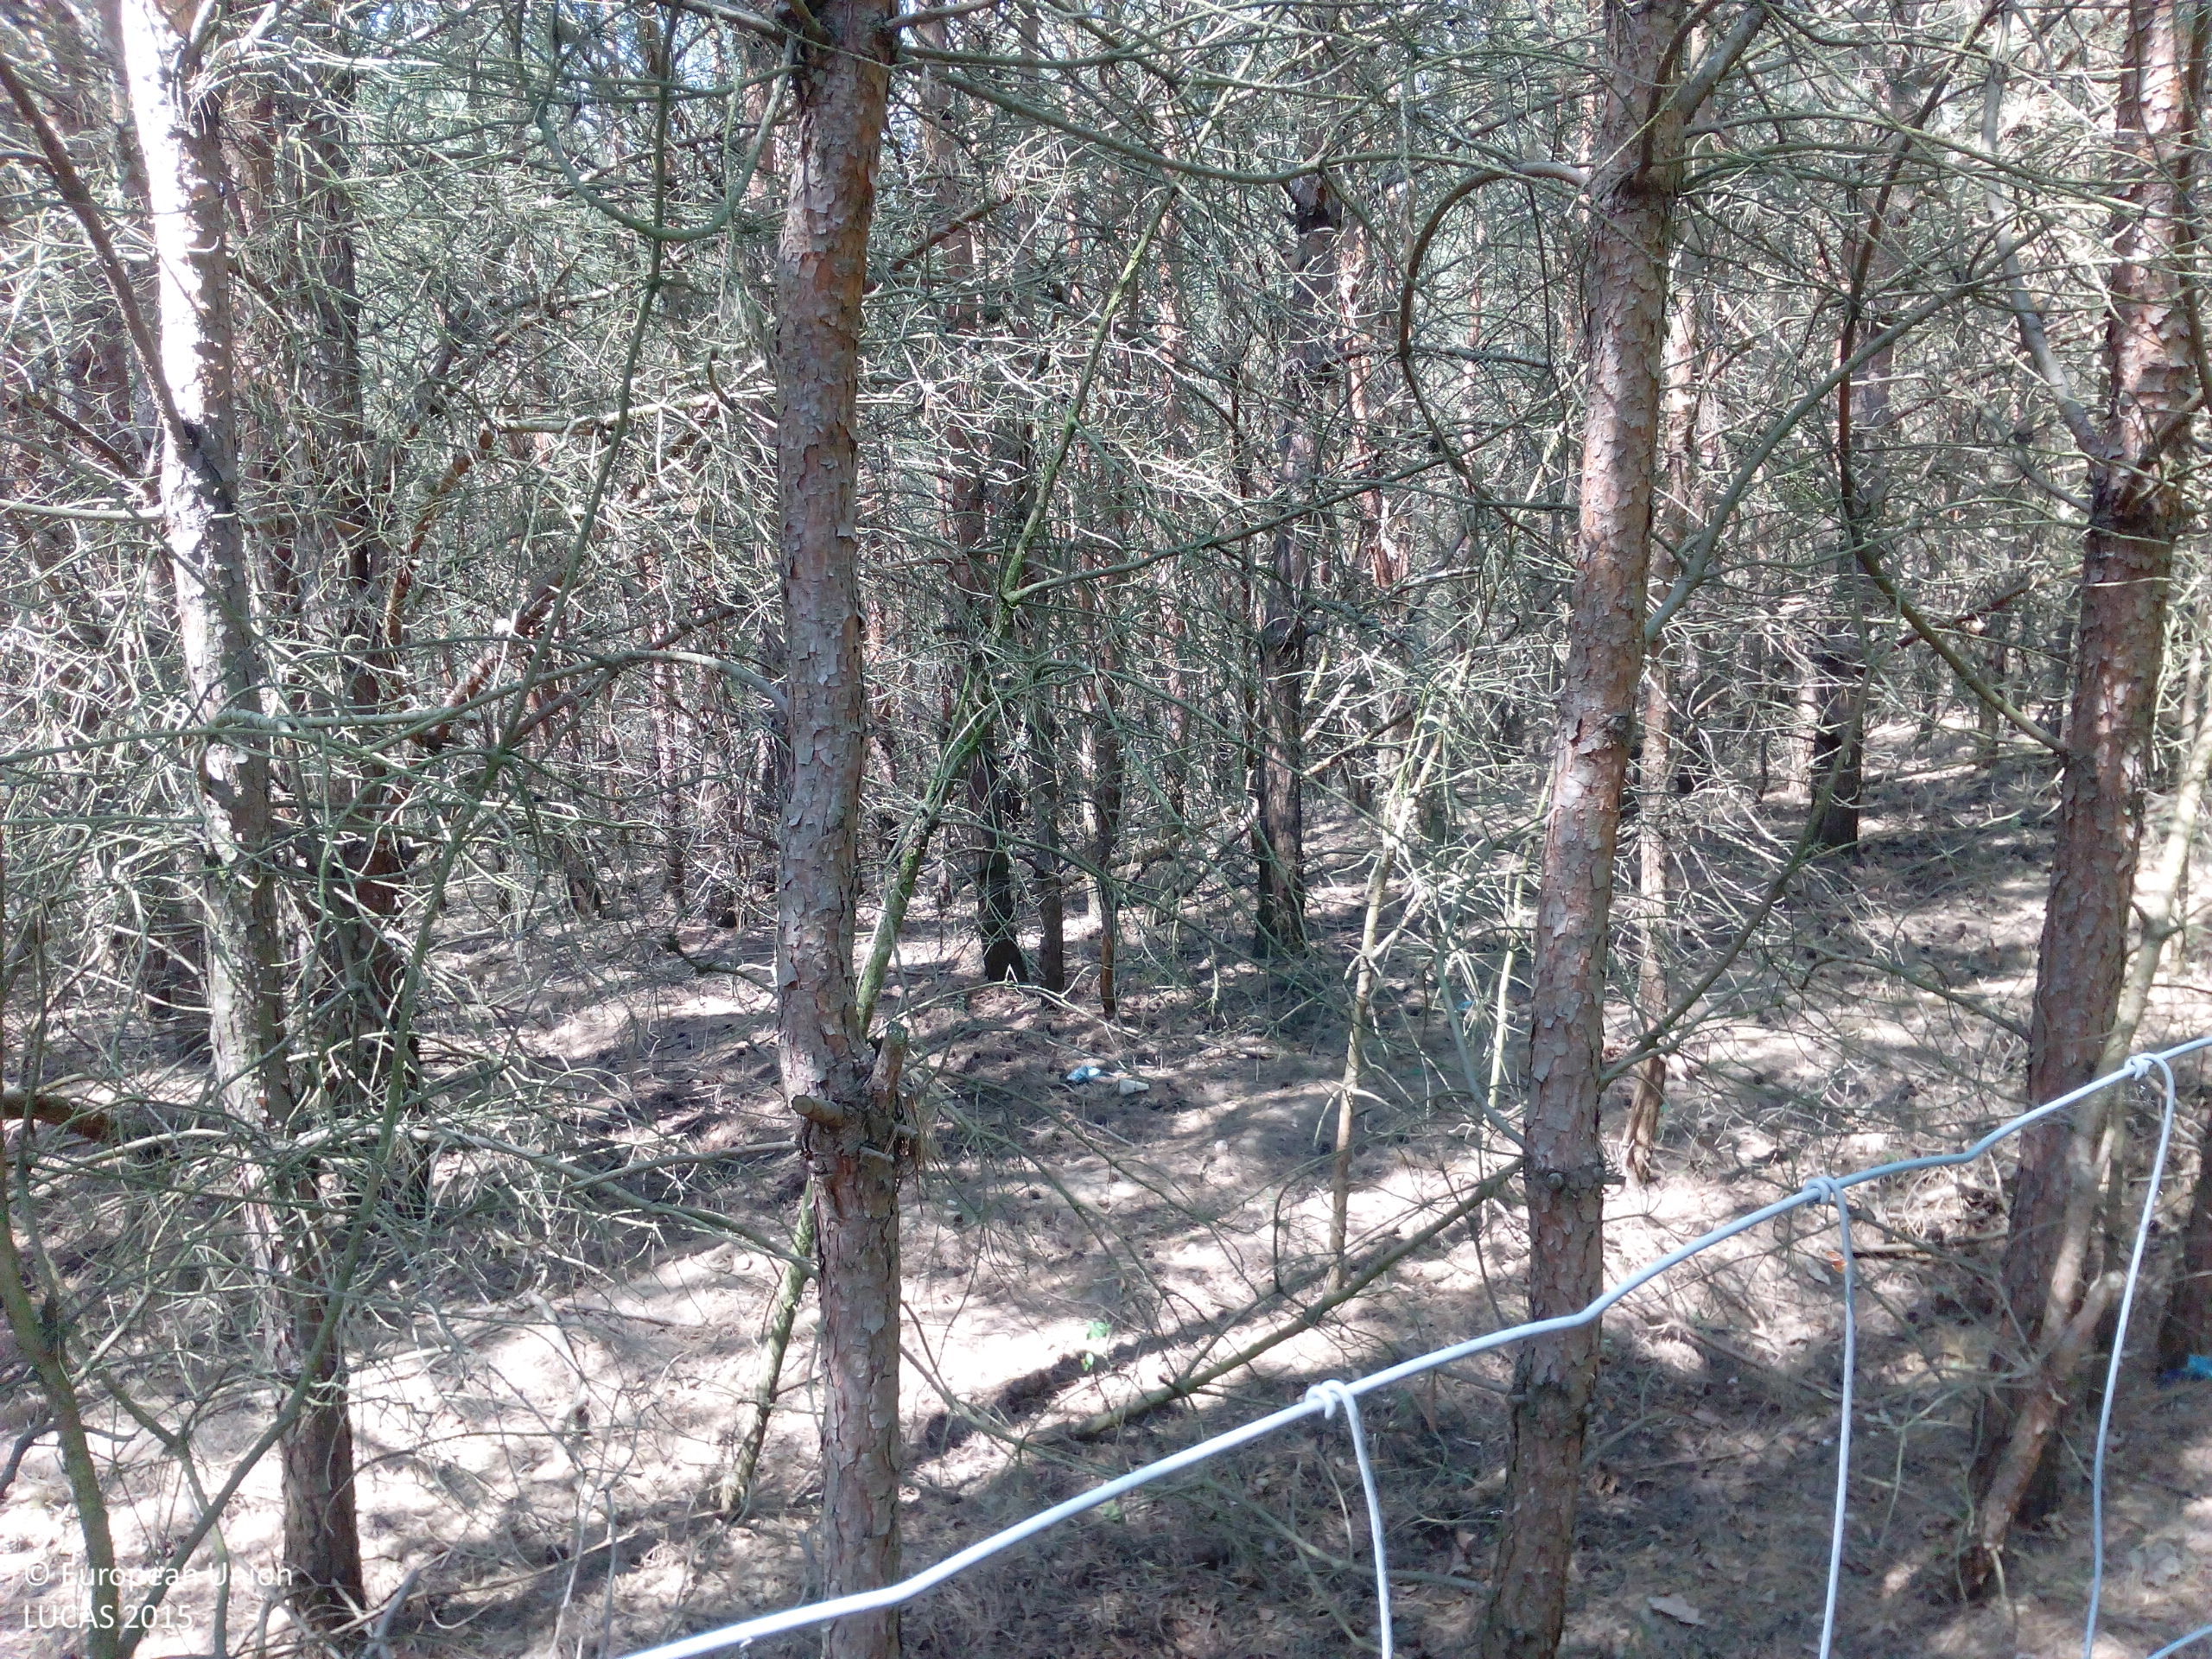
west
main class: Woodland
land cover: Pine dominated mixed woodland
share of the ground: > 75 %
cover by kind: coniferous forest trees 50 %, broadleaved forest trees 50 %
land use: Forestry
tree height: > 5 m
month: May
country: DE
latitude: 51.6343
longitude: 12.3836
